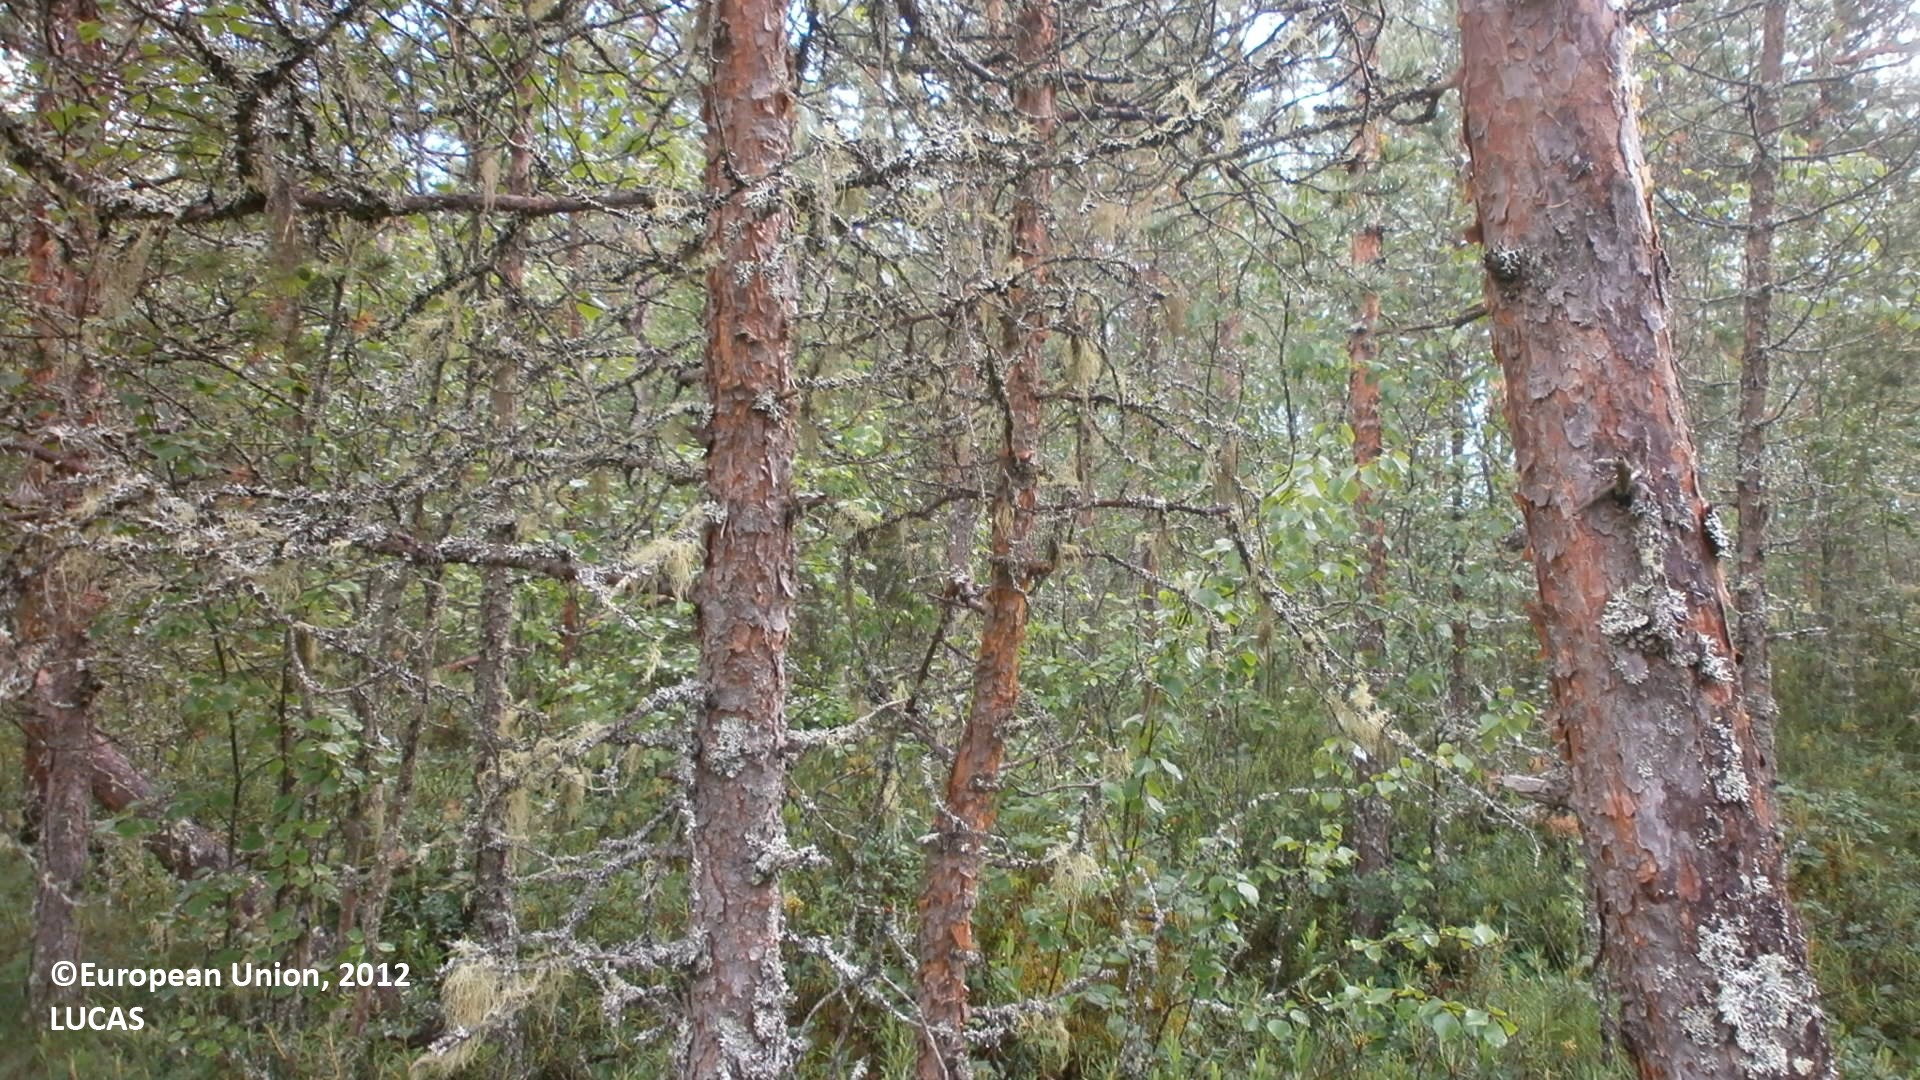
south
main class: Woodland
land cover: Pine dominated mixed woodland
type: mire and swamp forests
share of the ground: 50 - 75 %
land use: Forestry
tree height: > 5 m
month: July
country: FI
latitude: 64.4638
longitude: 24.3078
